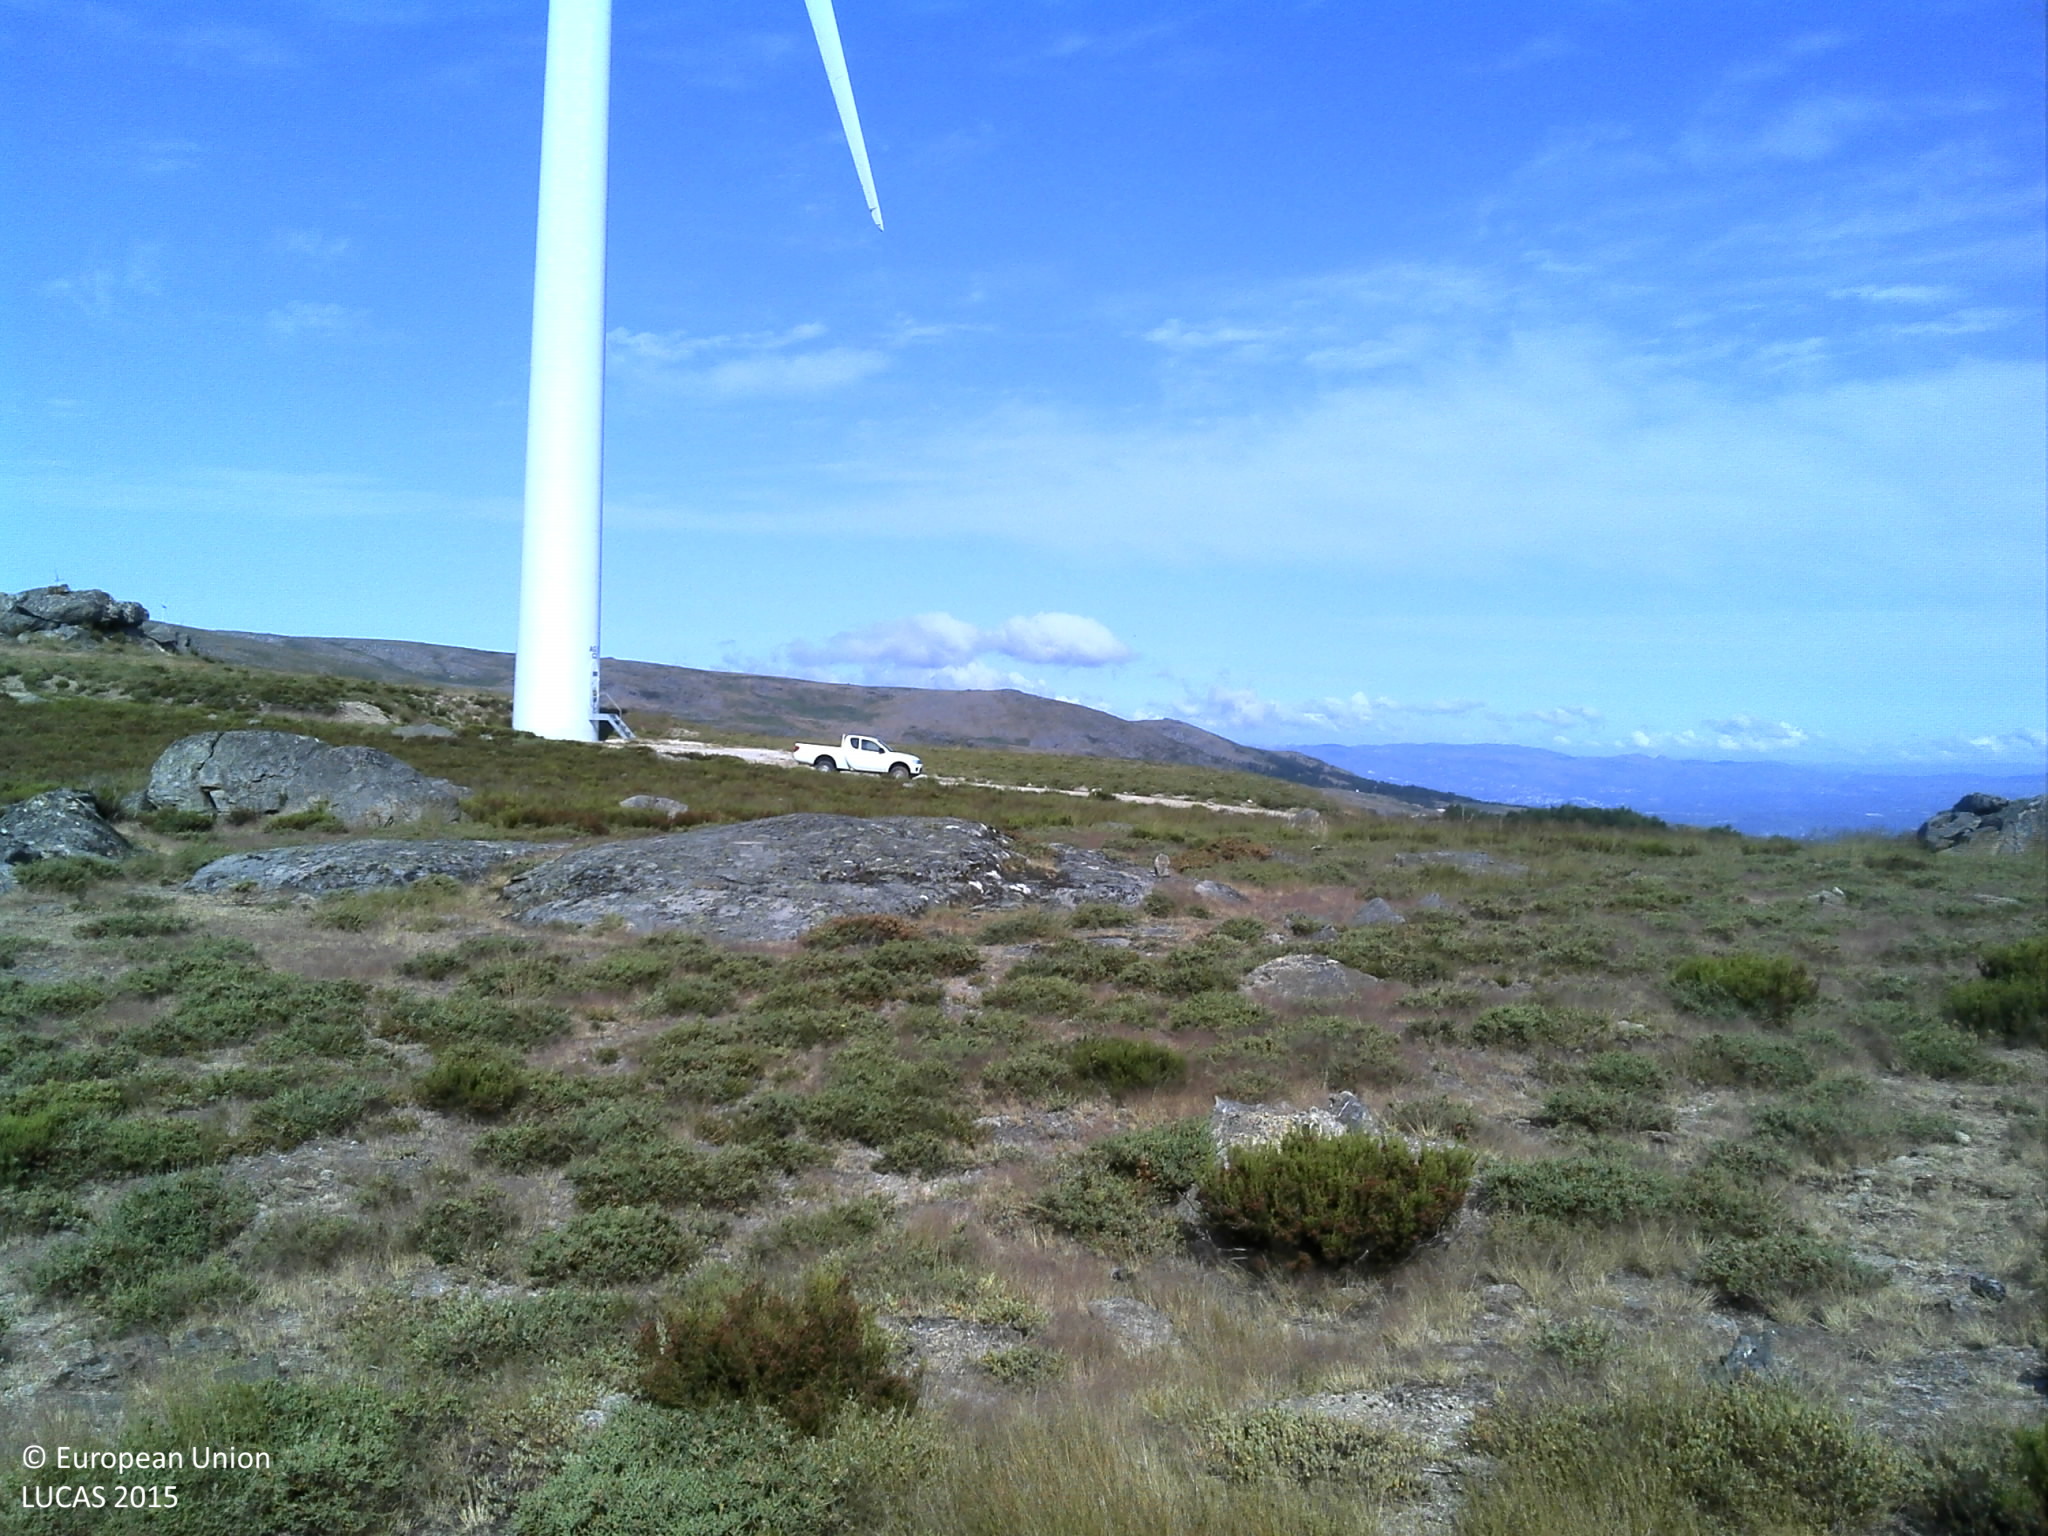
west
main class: Shrubland
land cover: Shrubland without tree cover
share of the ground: 50 - 75 %
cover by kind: shrubs 60 %, consolidated bare surface 30 %, unconsolidated bare surface 10 %
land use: Agriculture (excluding fallow land and kitchen gardens)
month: July
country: PT
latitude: 41.4248
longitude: -7.7337
